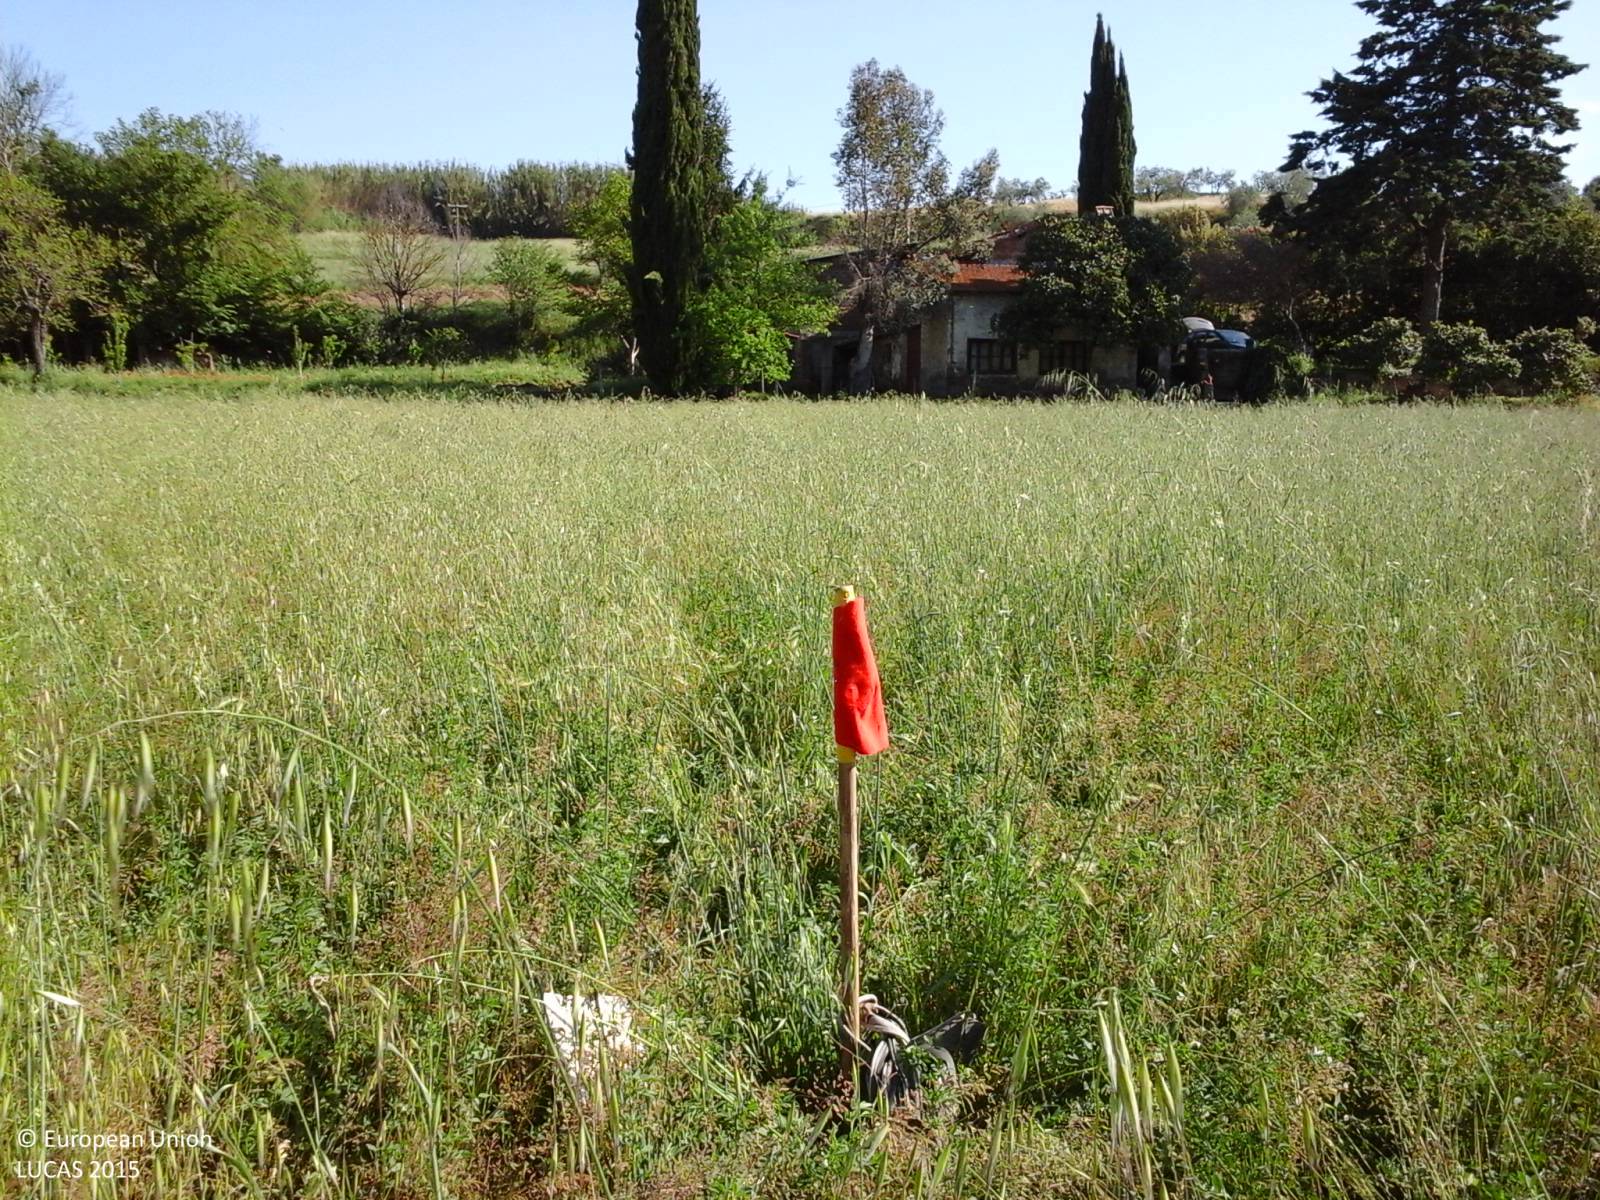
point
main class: Cropland
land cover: Oats
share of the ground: > 75 %
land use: Agriculture (excluding fallow land and kitchen gardens)
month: May
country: IT
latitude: 42.3985
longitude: 12.0461
